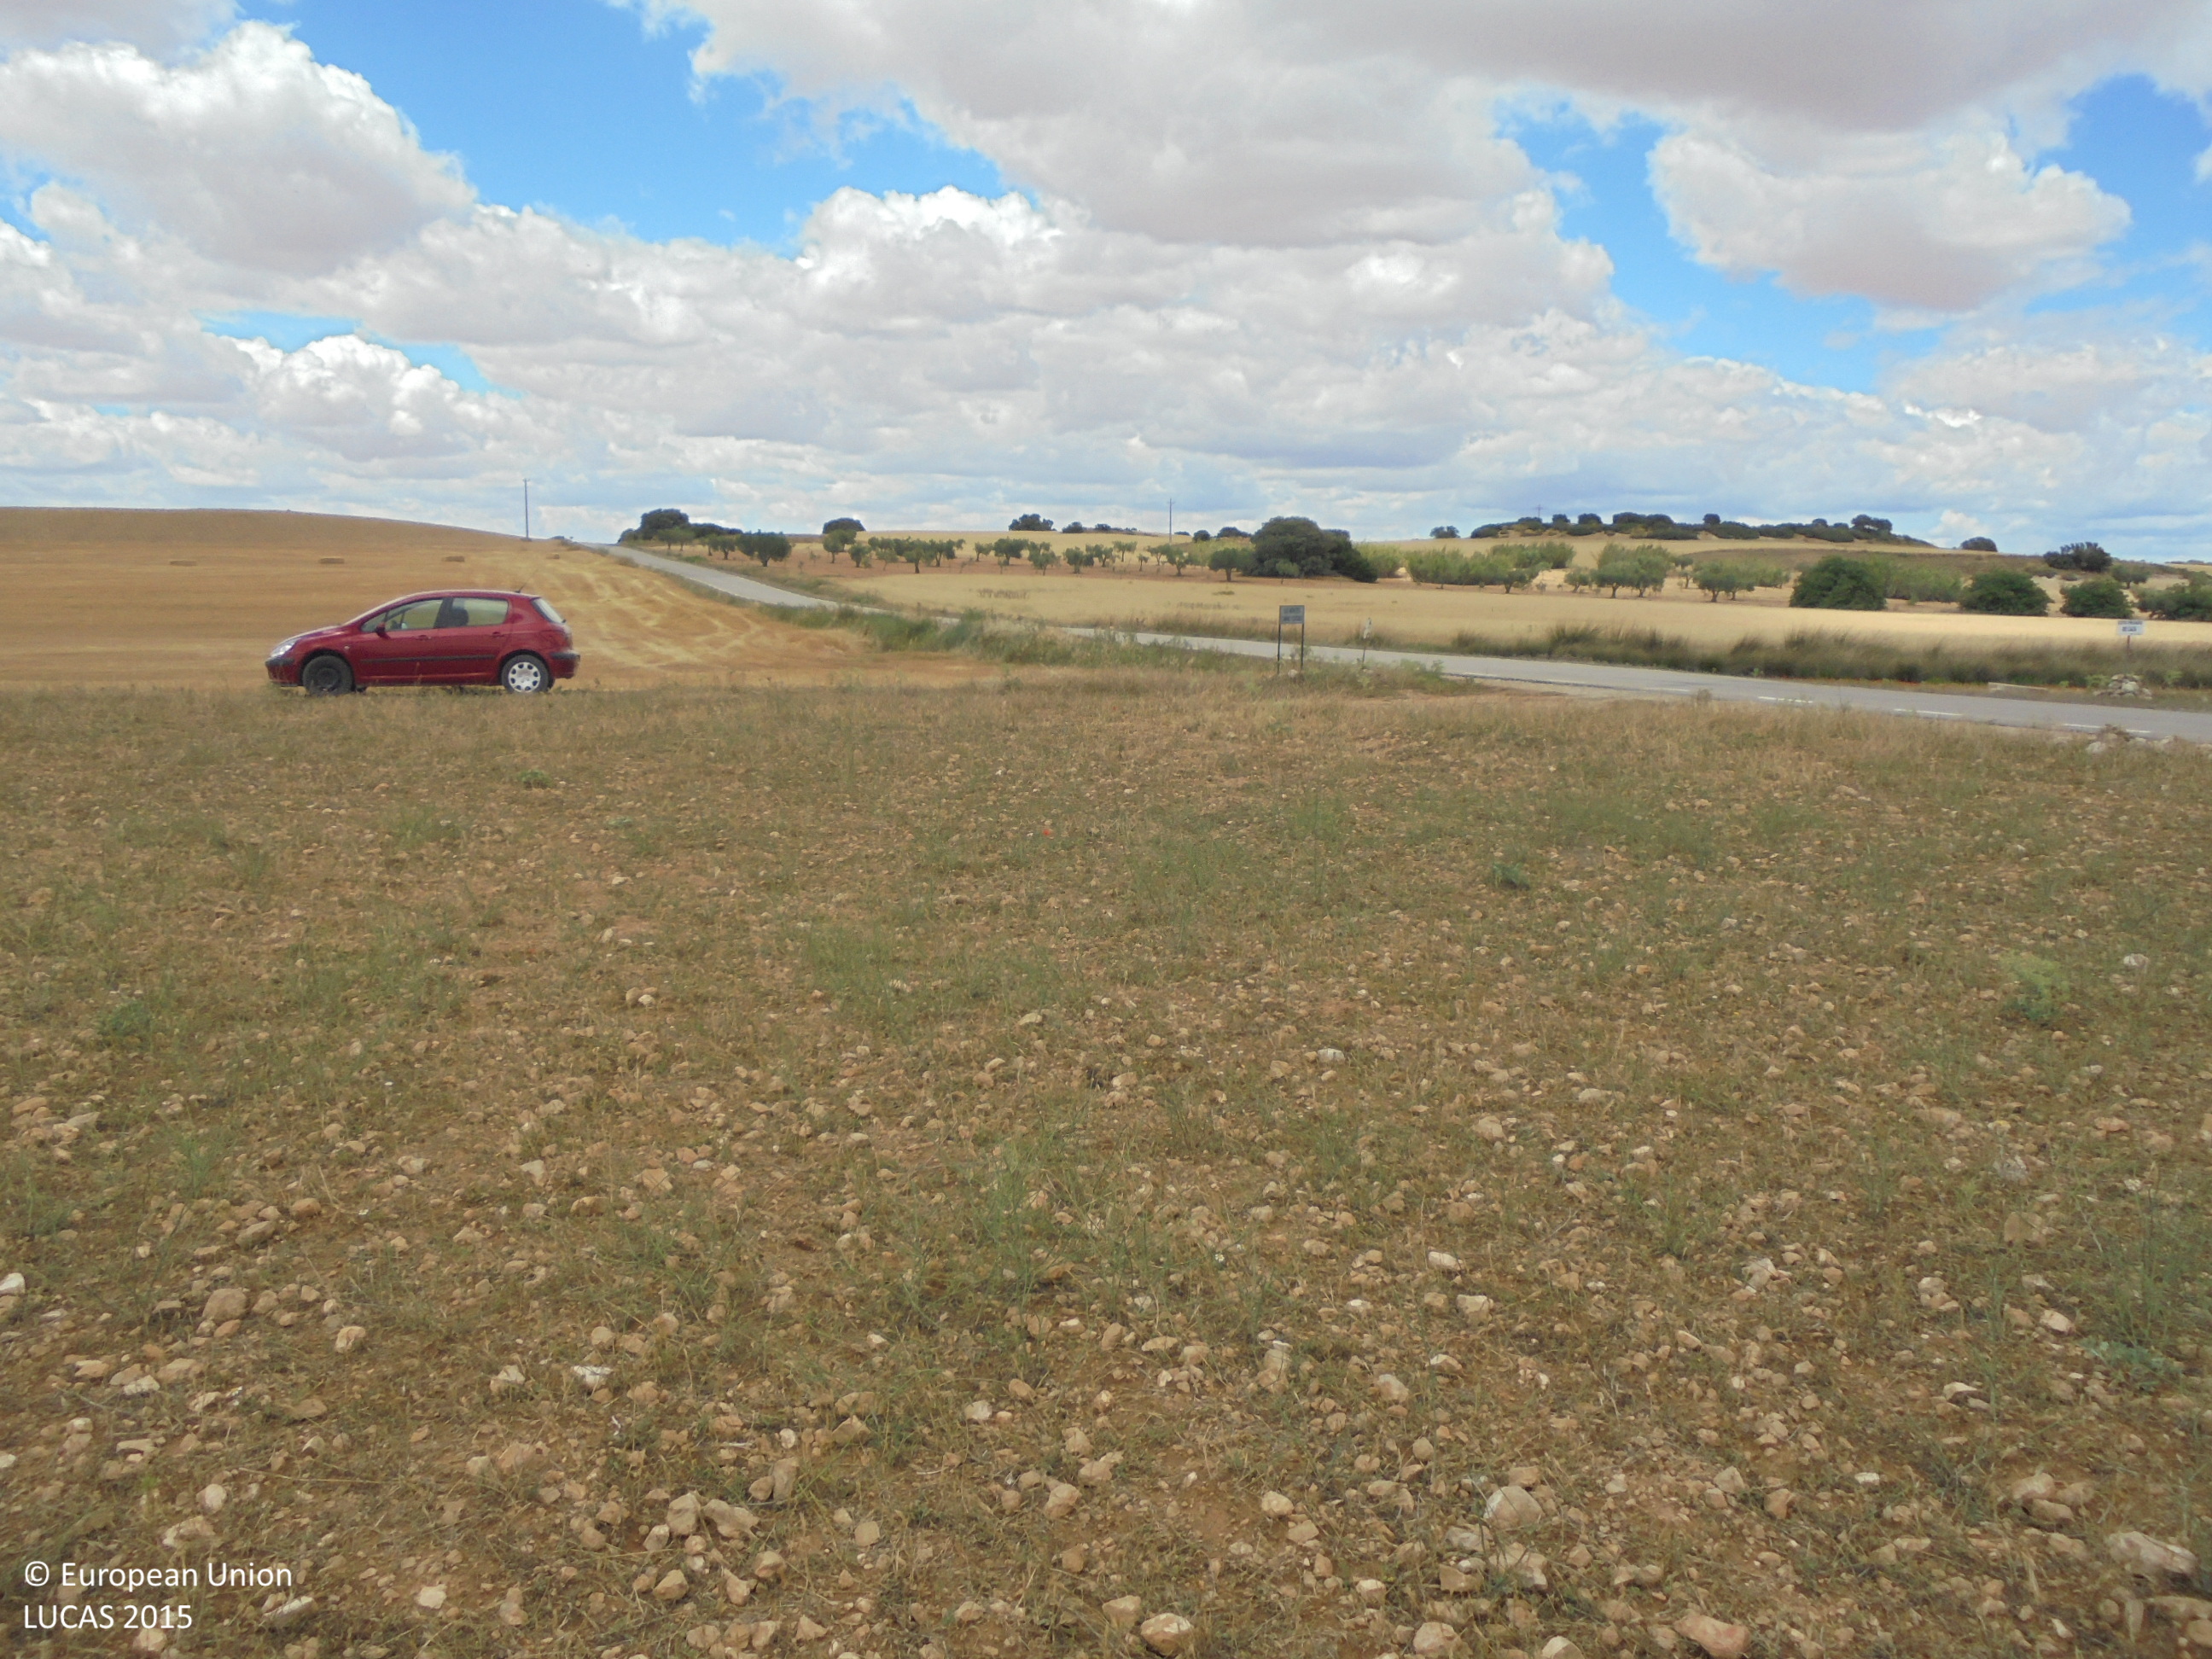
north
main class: Grassland
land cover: Spontaneously vegetated surfaces
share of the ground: 25 - 50 %
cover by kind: unconsolidated bare surface 55 %, herbaceous plants 45 %
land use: Agriculture (excluding fallow land and kitchen gardens)
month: June
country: ES
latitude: 38.7936
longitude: -1.4279
